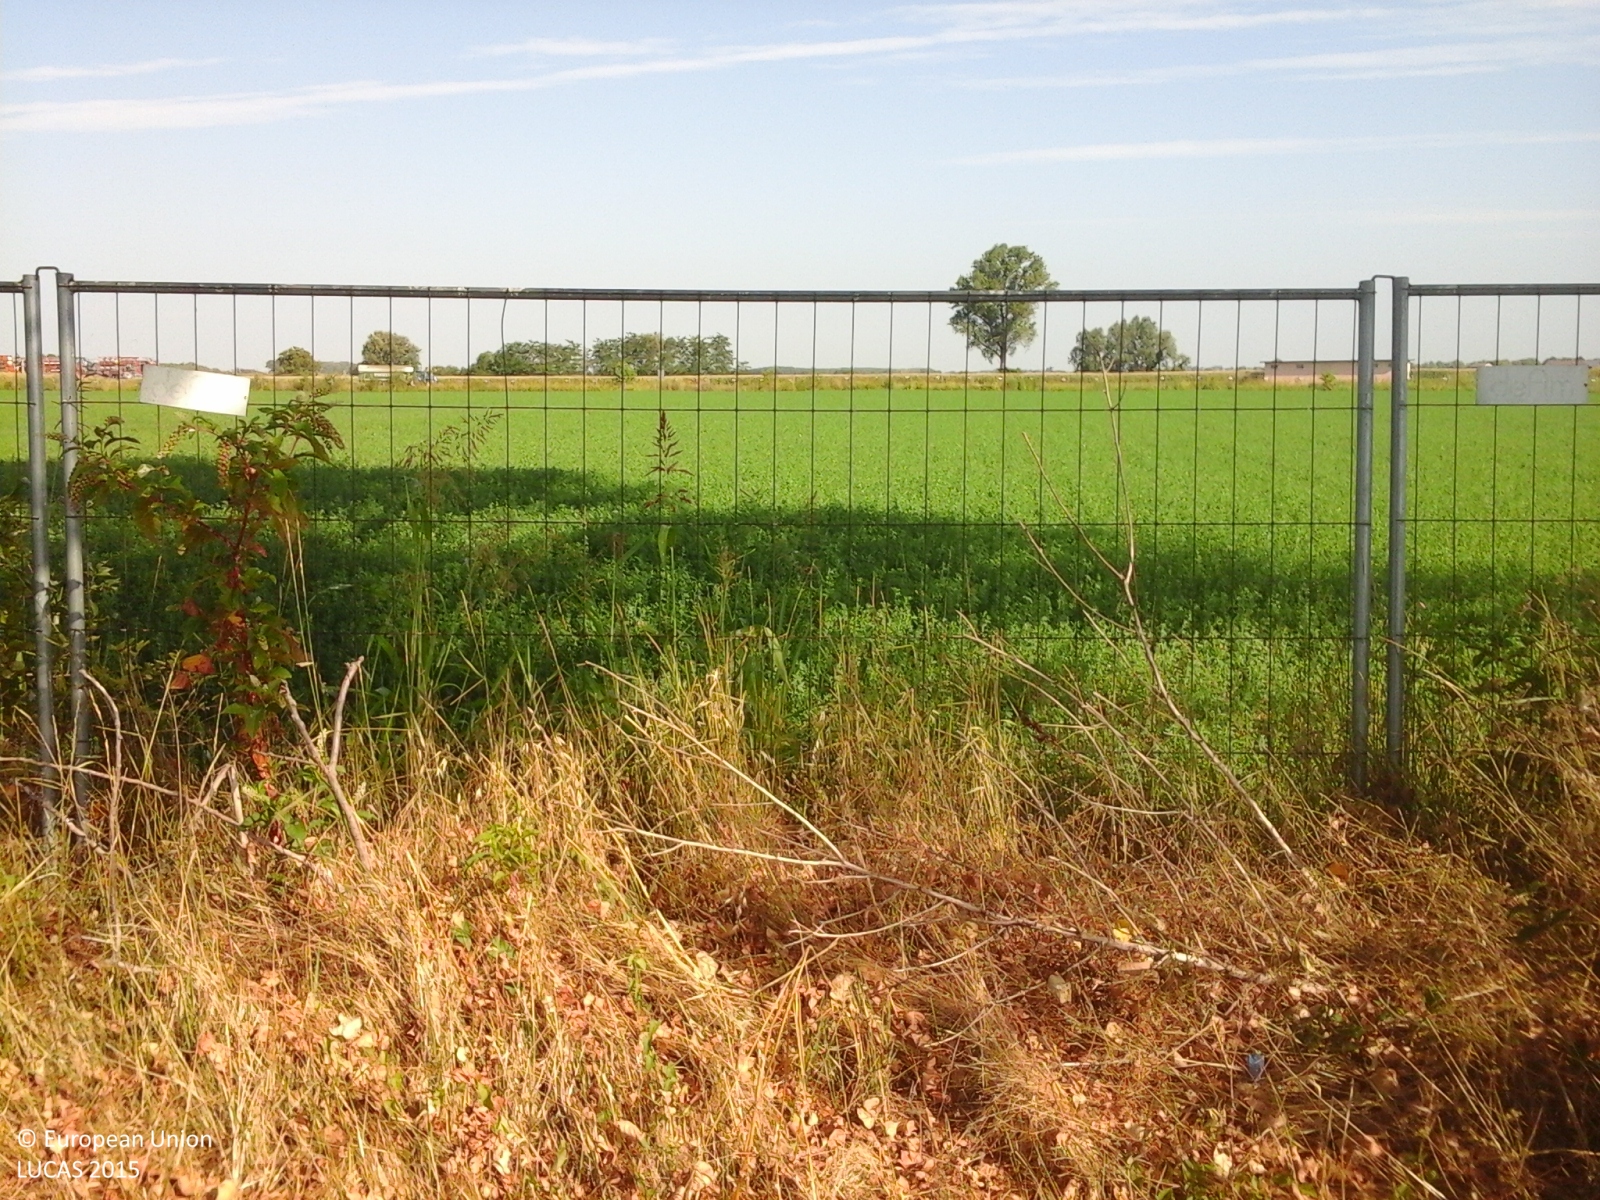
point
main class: Cropland
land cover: Lucerne
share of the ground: > 75 %
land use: Agriculture (excluding fallow land and kitchen gardens)
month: July
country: IT
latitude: 45.0860
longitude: 9.0997
